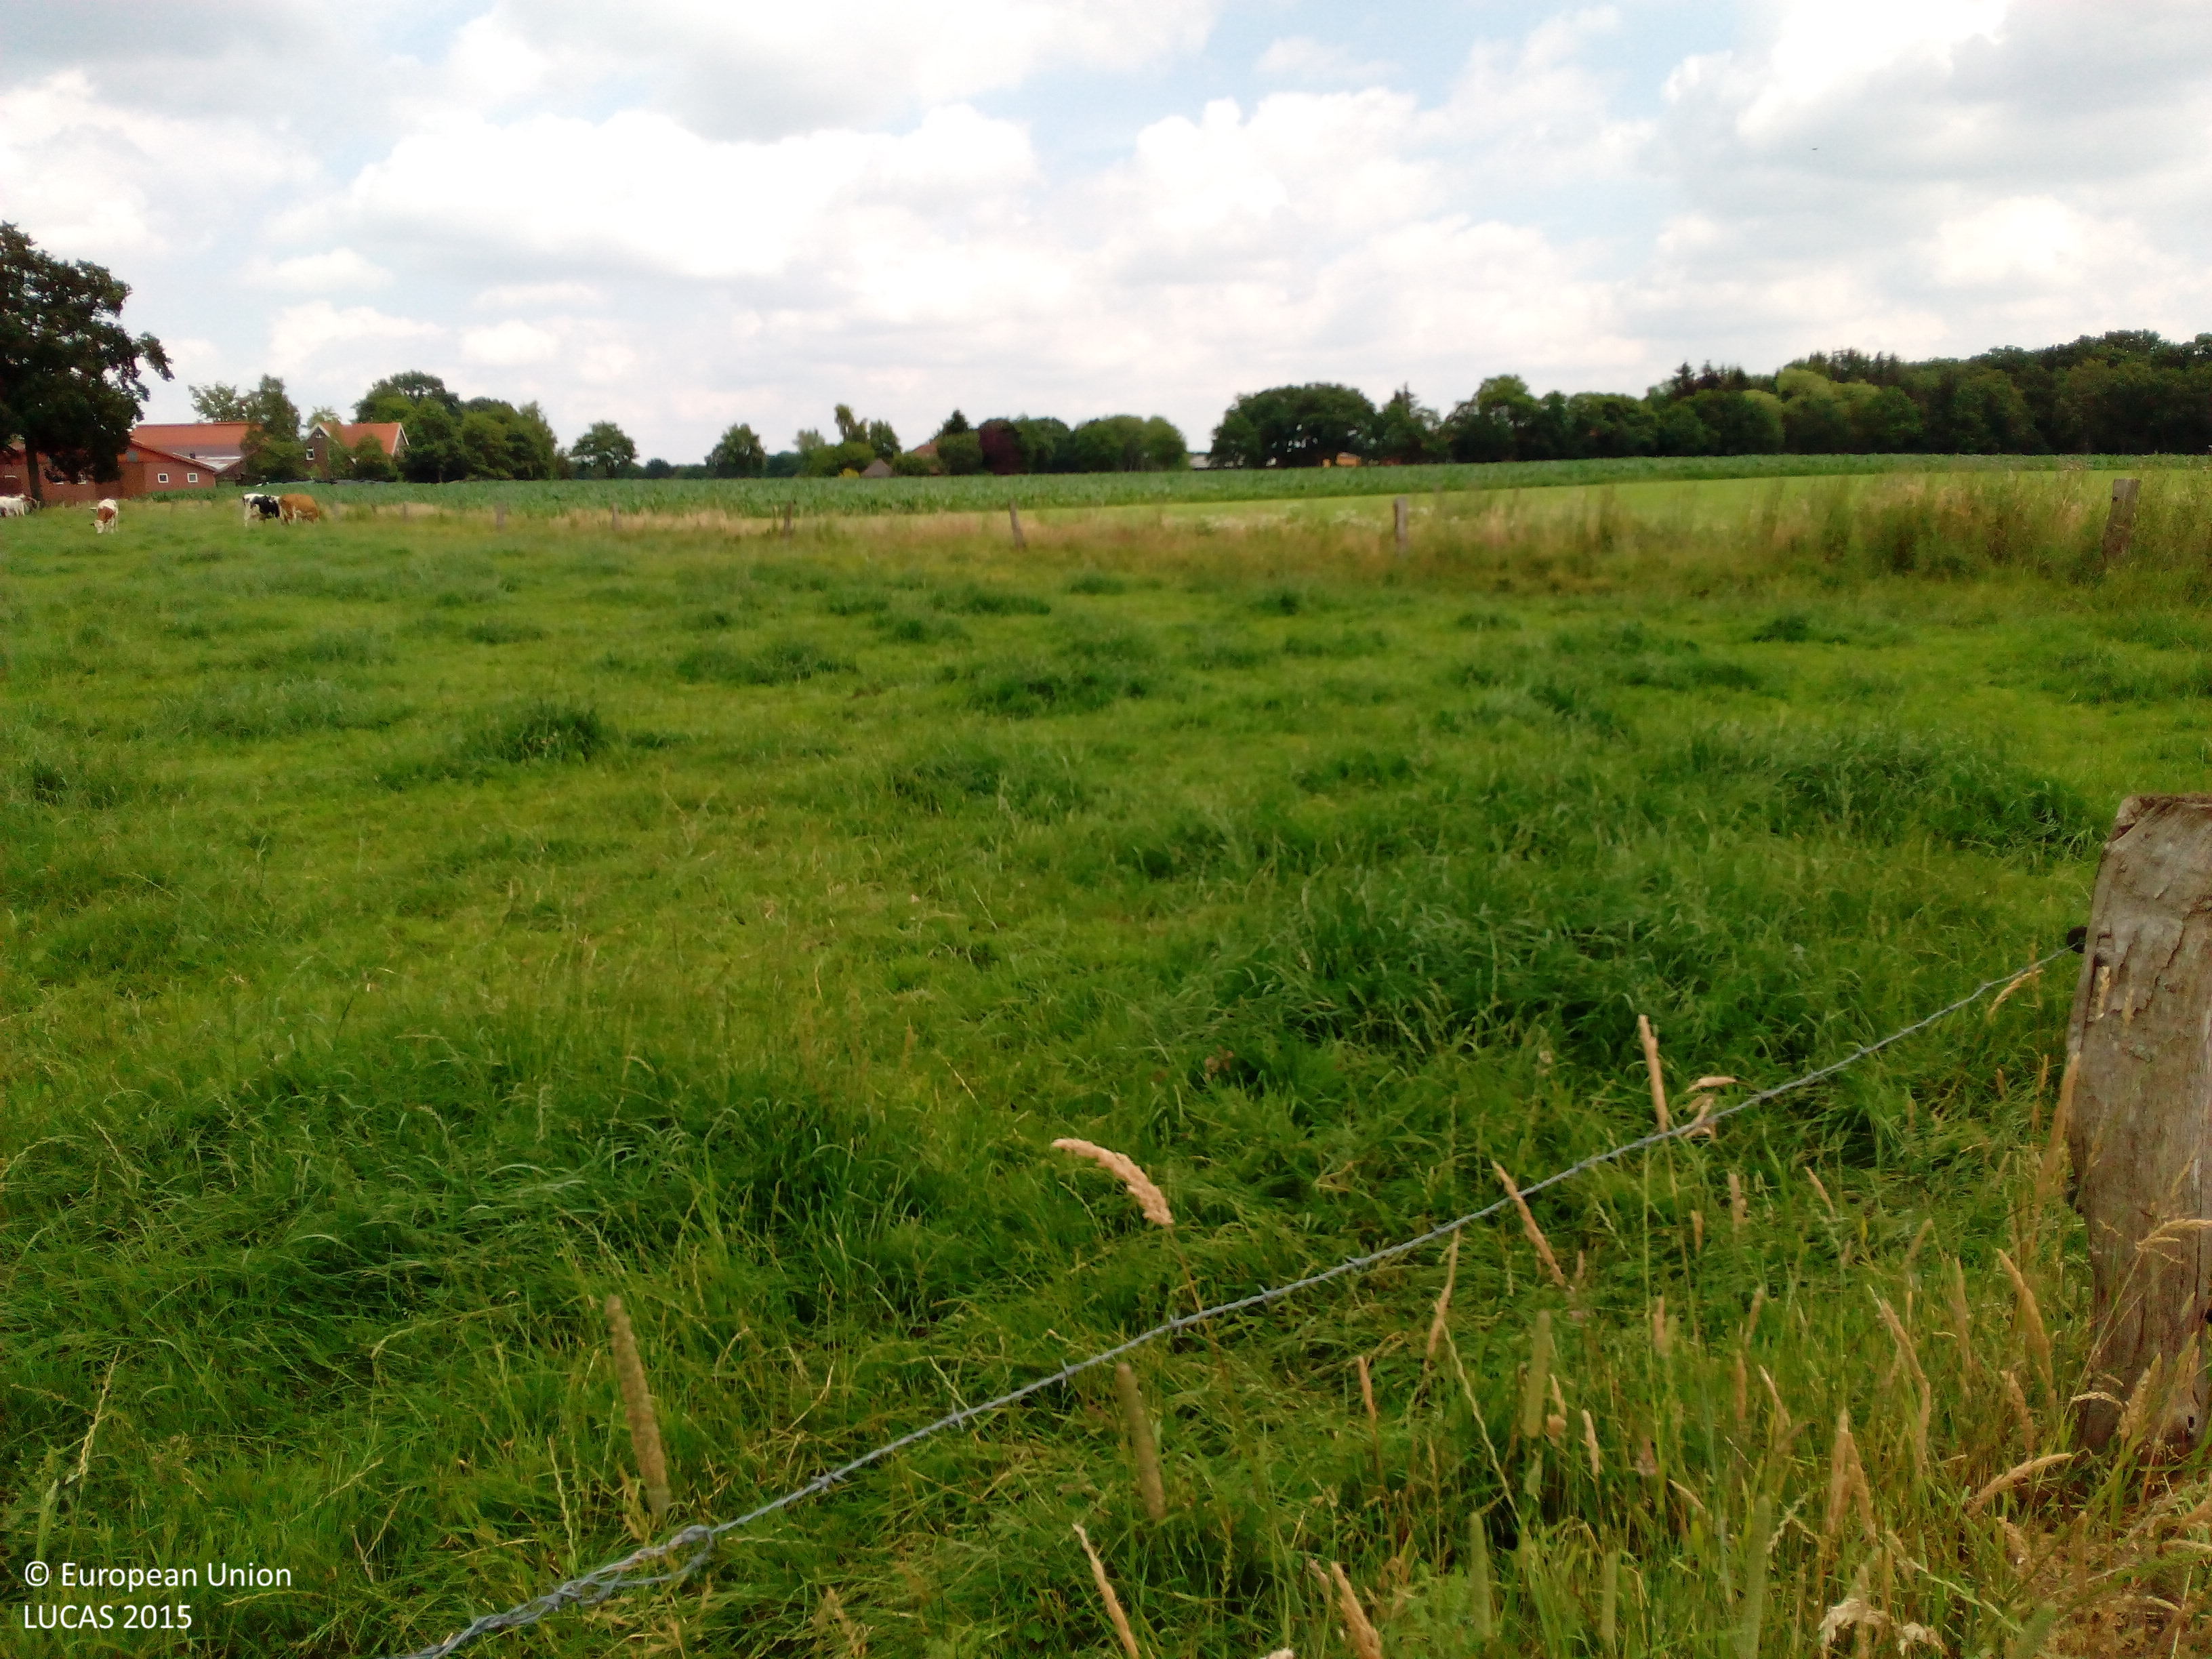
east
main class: Grassland
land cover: Grassland without tree/shrub cover
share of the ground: > 75 %
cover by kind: herbaceous plants 100 %
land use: Agriculture (excluding fallow land and kitchen gardens)
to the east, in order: Grassland without tree/shrub cover; Fences; Grassland without tree/shrub cover; Fences; Grassland without tree/shrub cover; Maize; Fences; Grassland without tree/shrub cover
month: July
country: DE
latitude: 53.3126
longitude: 7.9444
